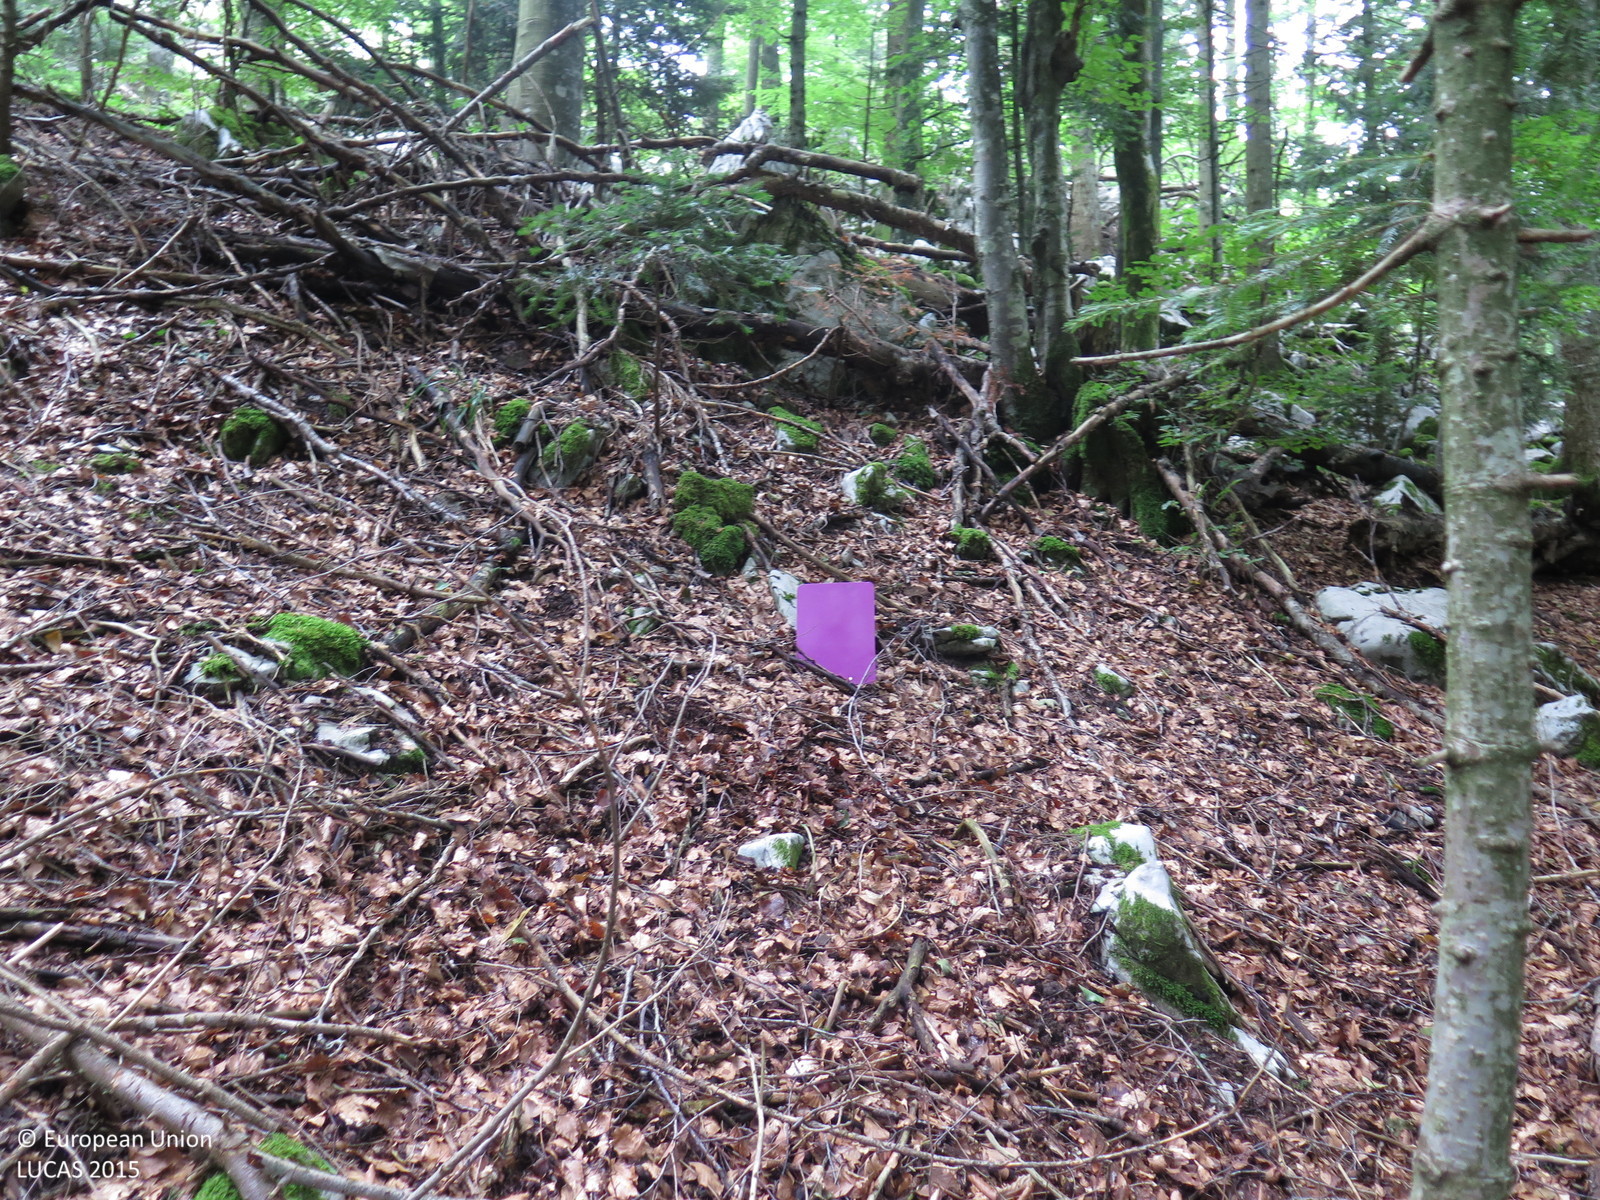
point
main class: Woodland
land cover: Other coniferous woodland
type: alpine coniferous forest
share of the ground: > 75 %
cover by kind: coniferous forest trees 75 %, broadleaved forest trees 25 %
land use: Forestry
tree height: > 5 m
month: August
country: HR
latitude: 45.0808
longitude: 14.9617
